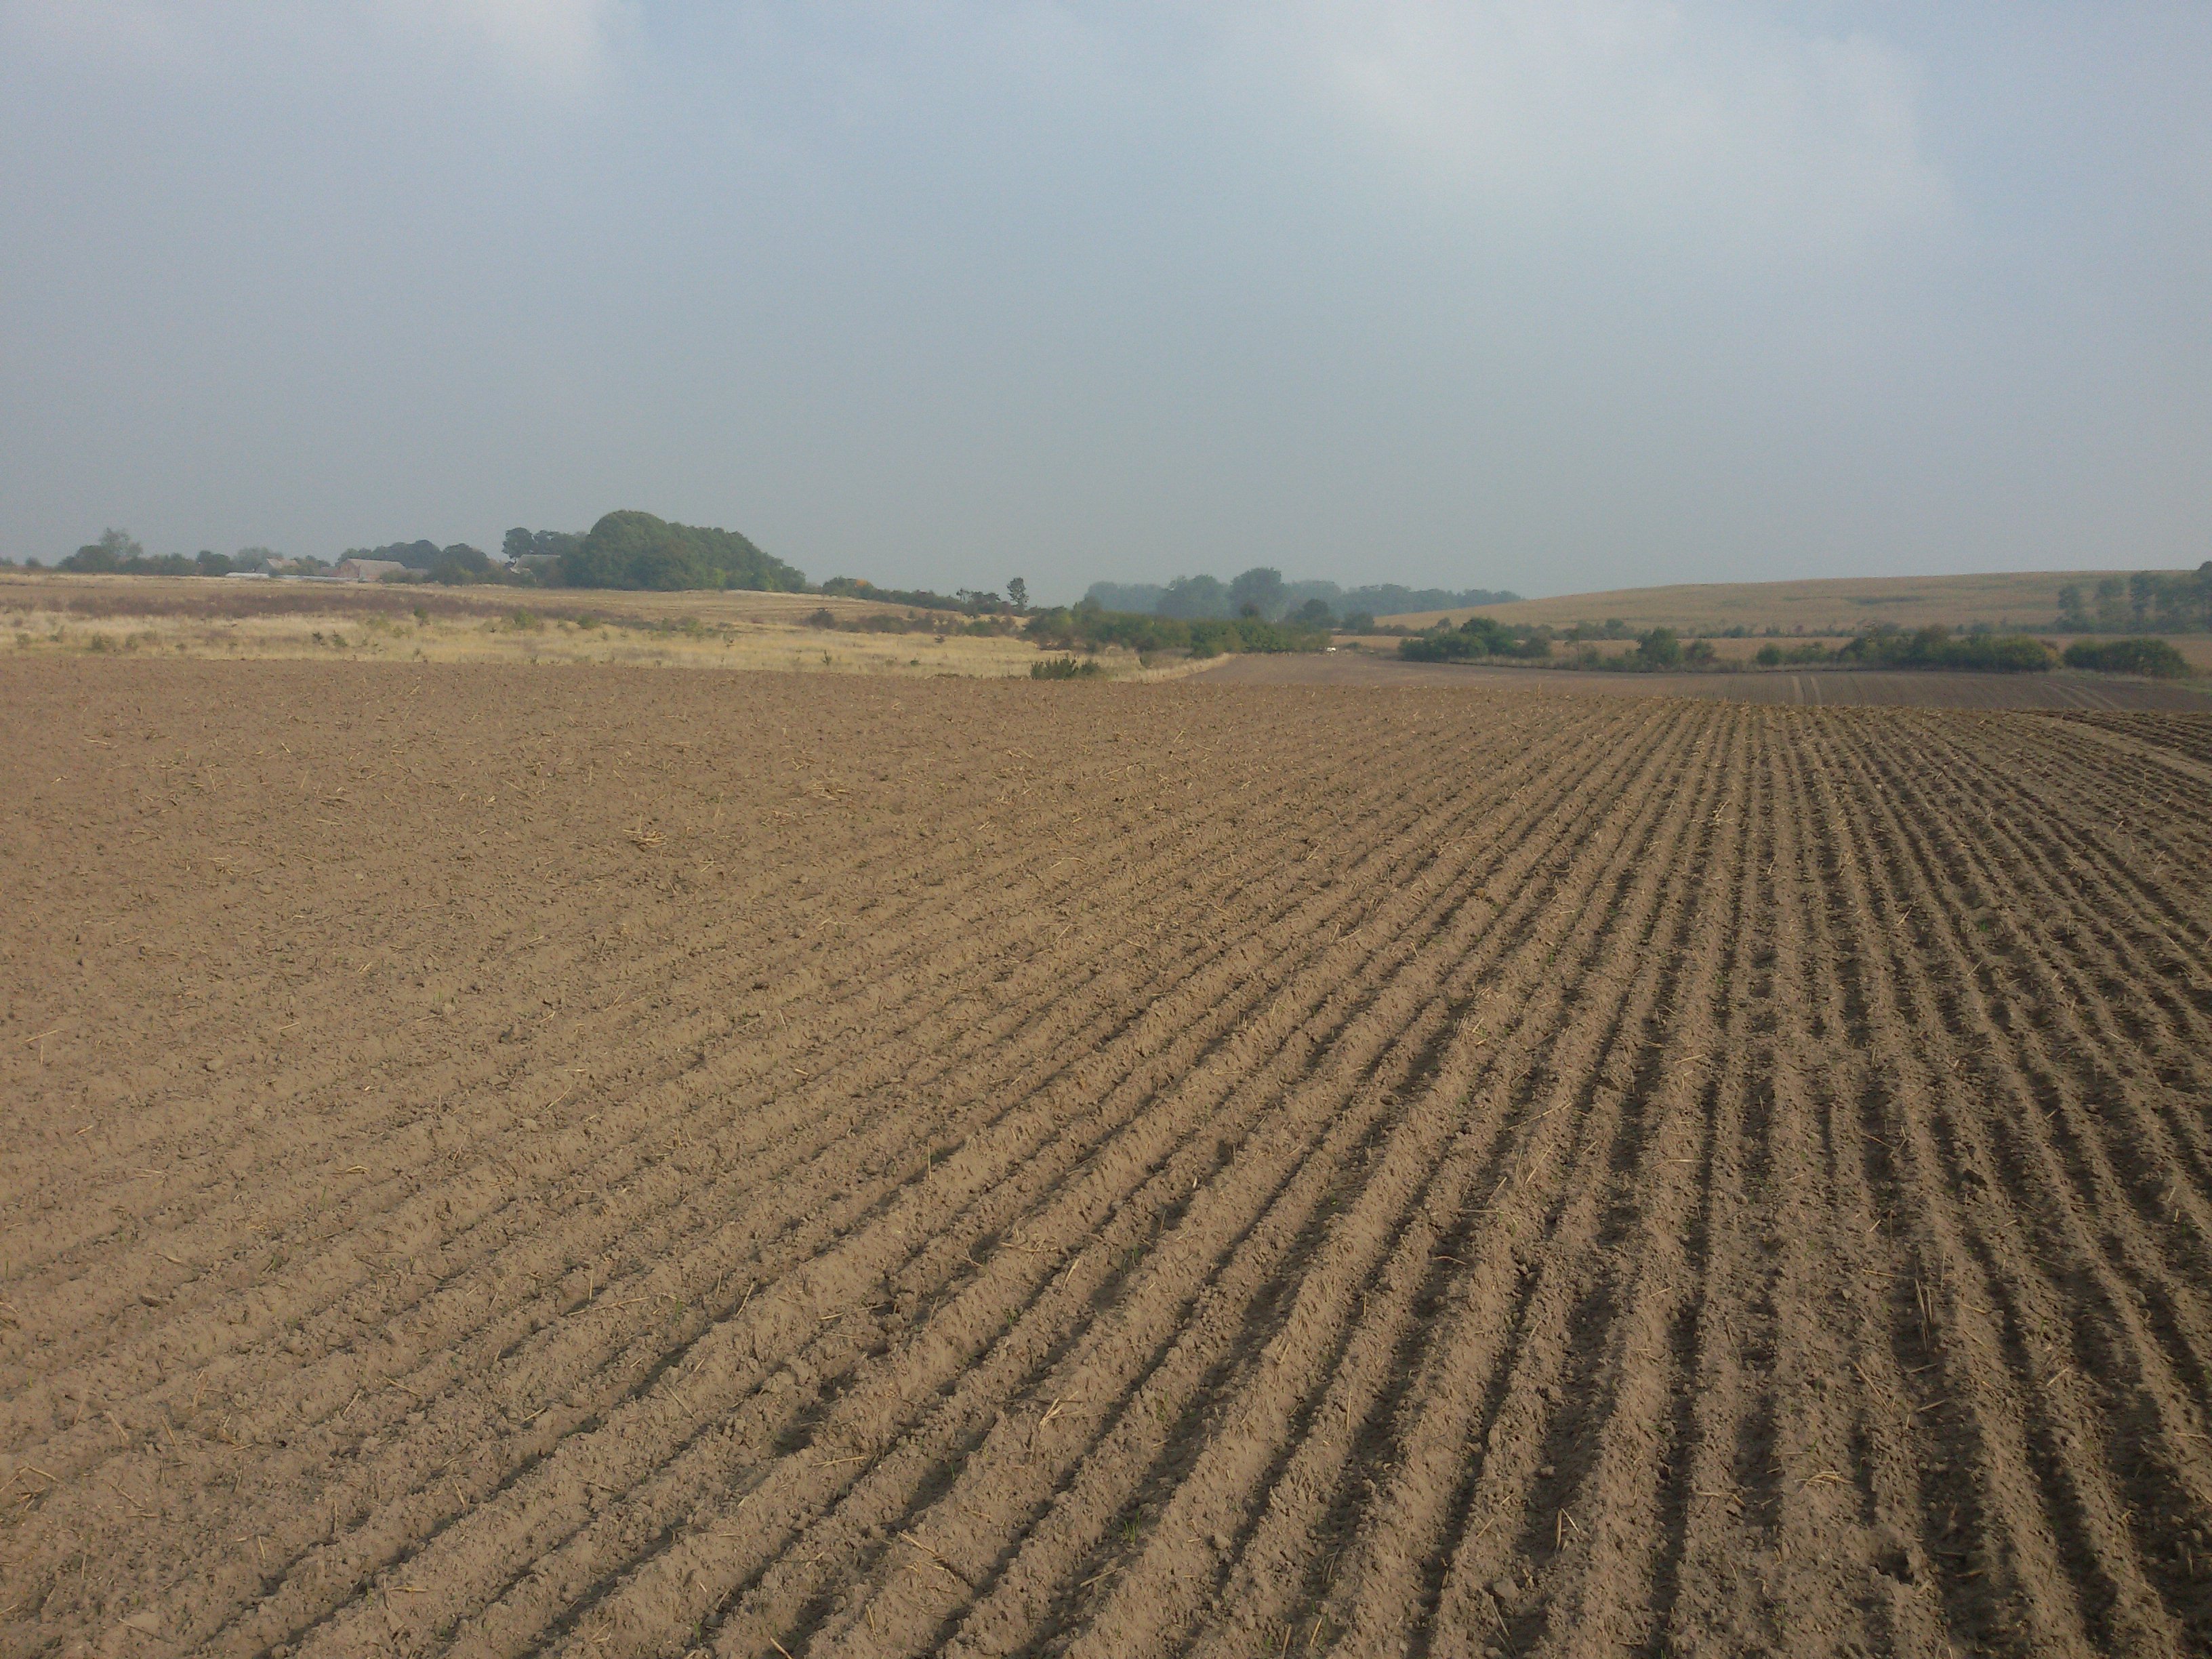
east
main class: Cropland
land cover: Barley
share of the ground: < 10 %
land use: Agriculture (excluding fallow land and kitchen gardens)
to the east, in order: Barley
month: October
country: PL
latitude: 53.1574
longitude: 14.4728
